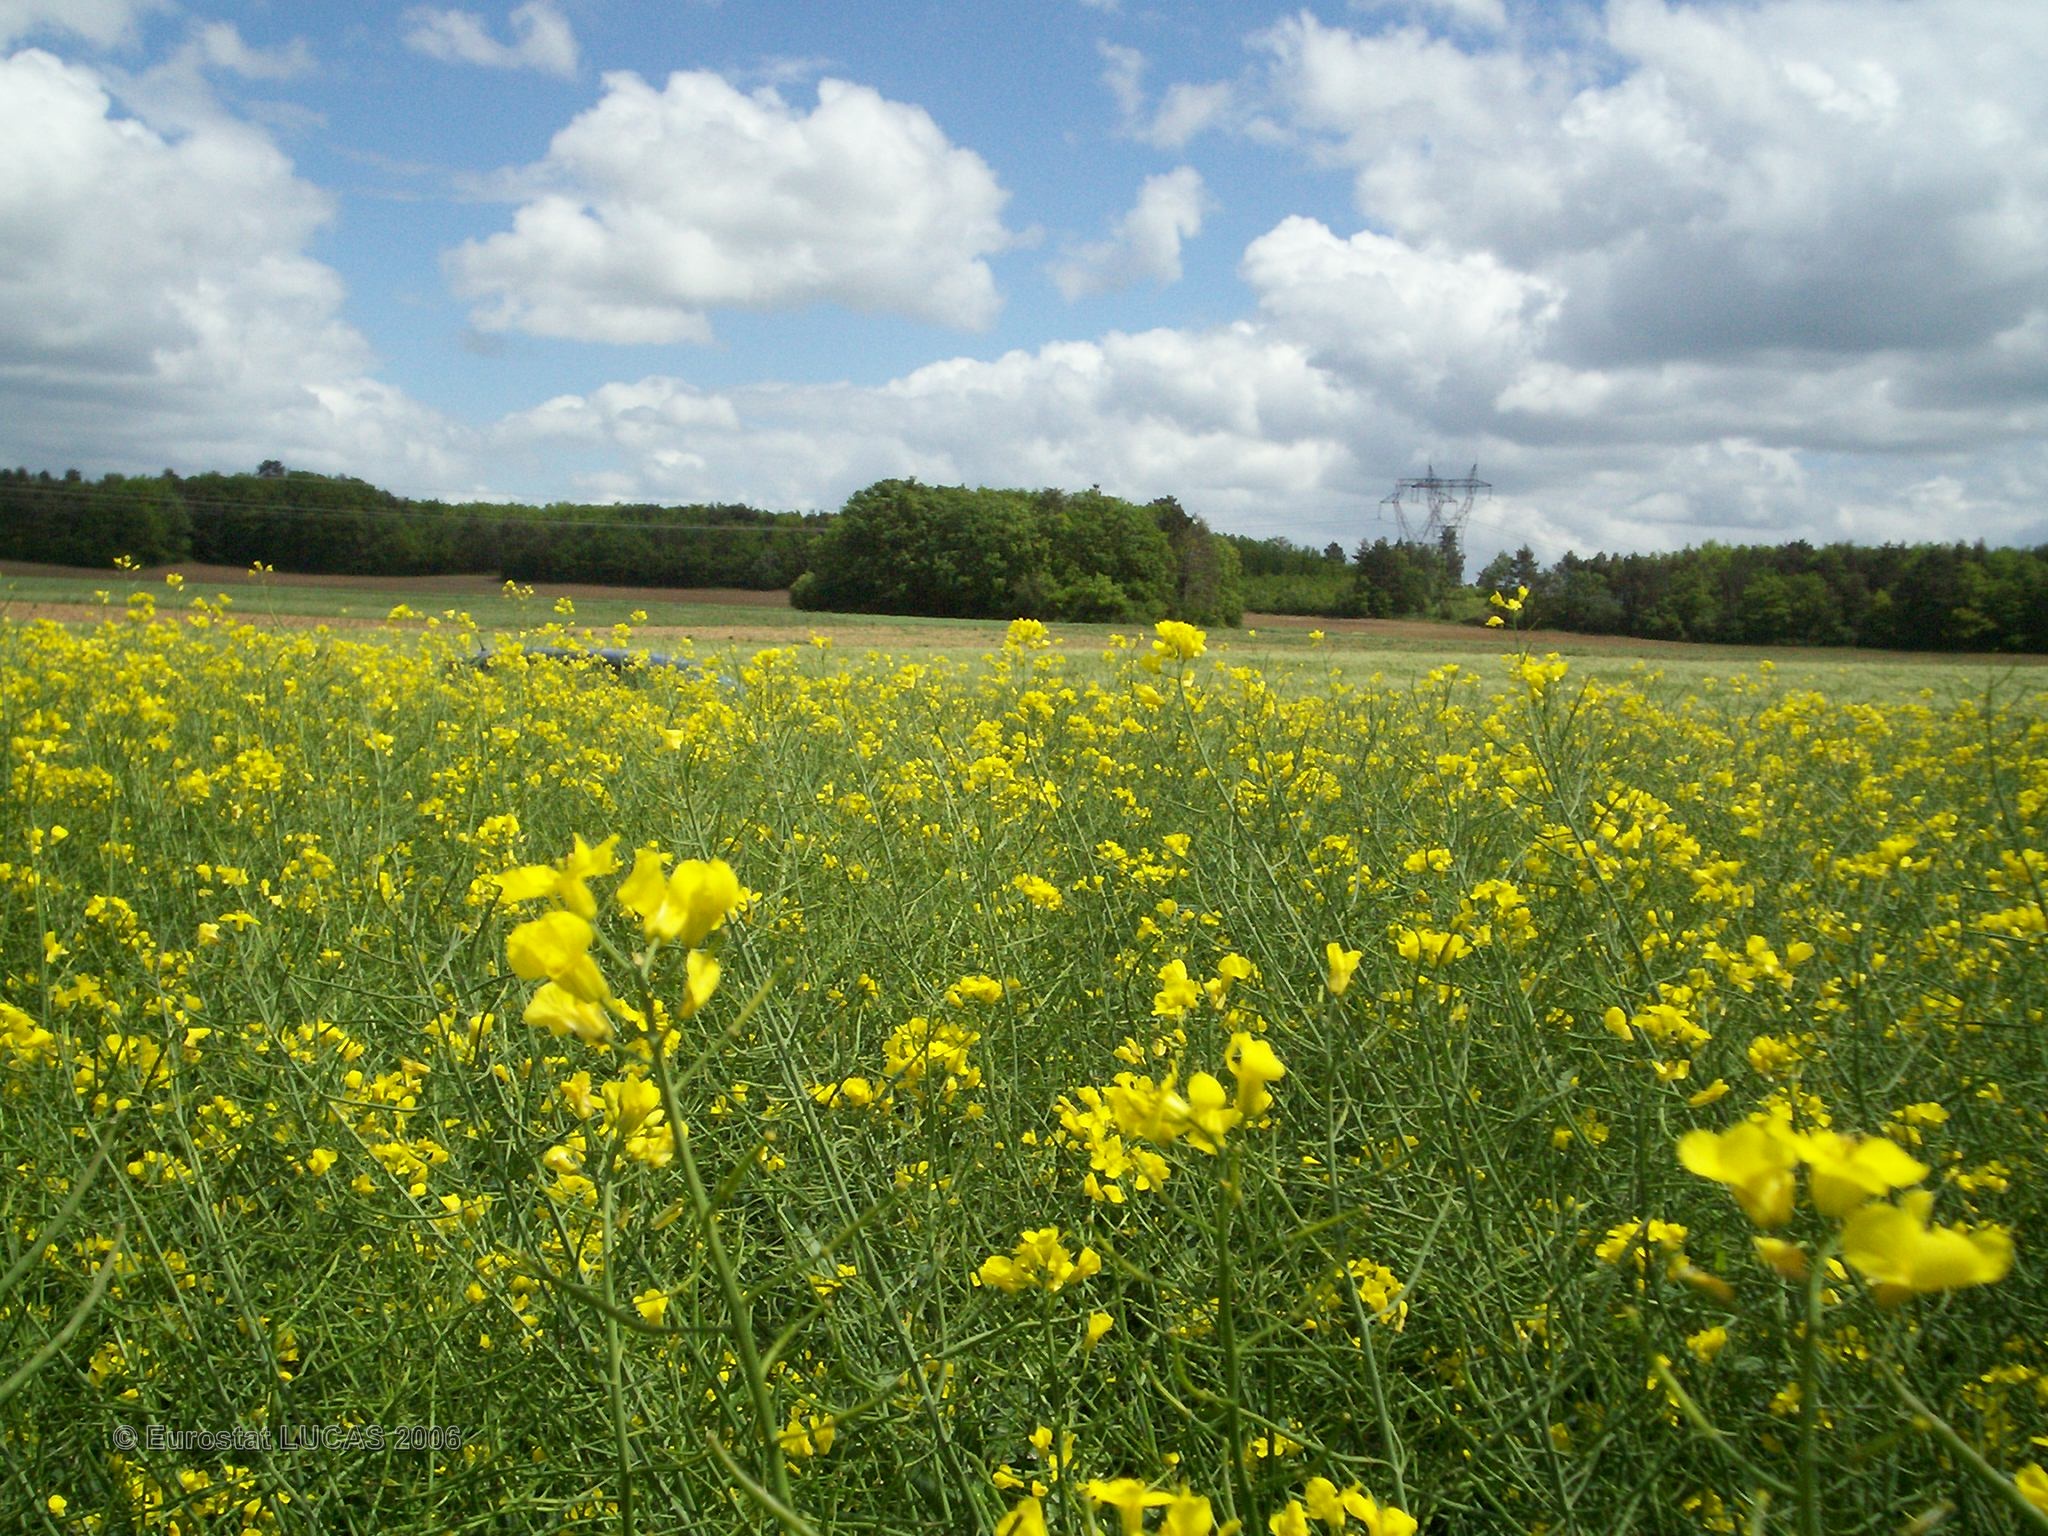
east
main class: Cropland
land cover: Rape and turnip rape
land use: Agriculture (excluding fallow land and kitchen gardens)
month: May
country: FR
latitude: 47.7208
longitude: 4.0652
